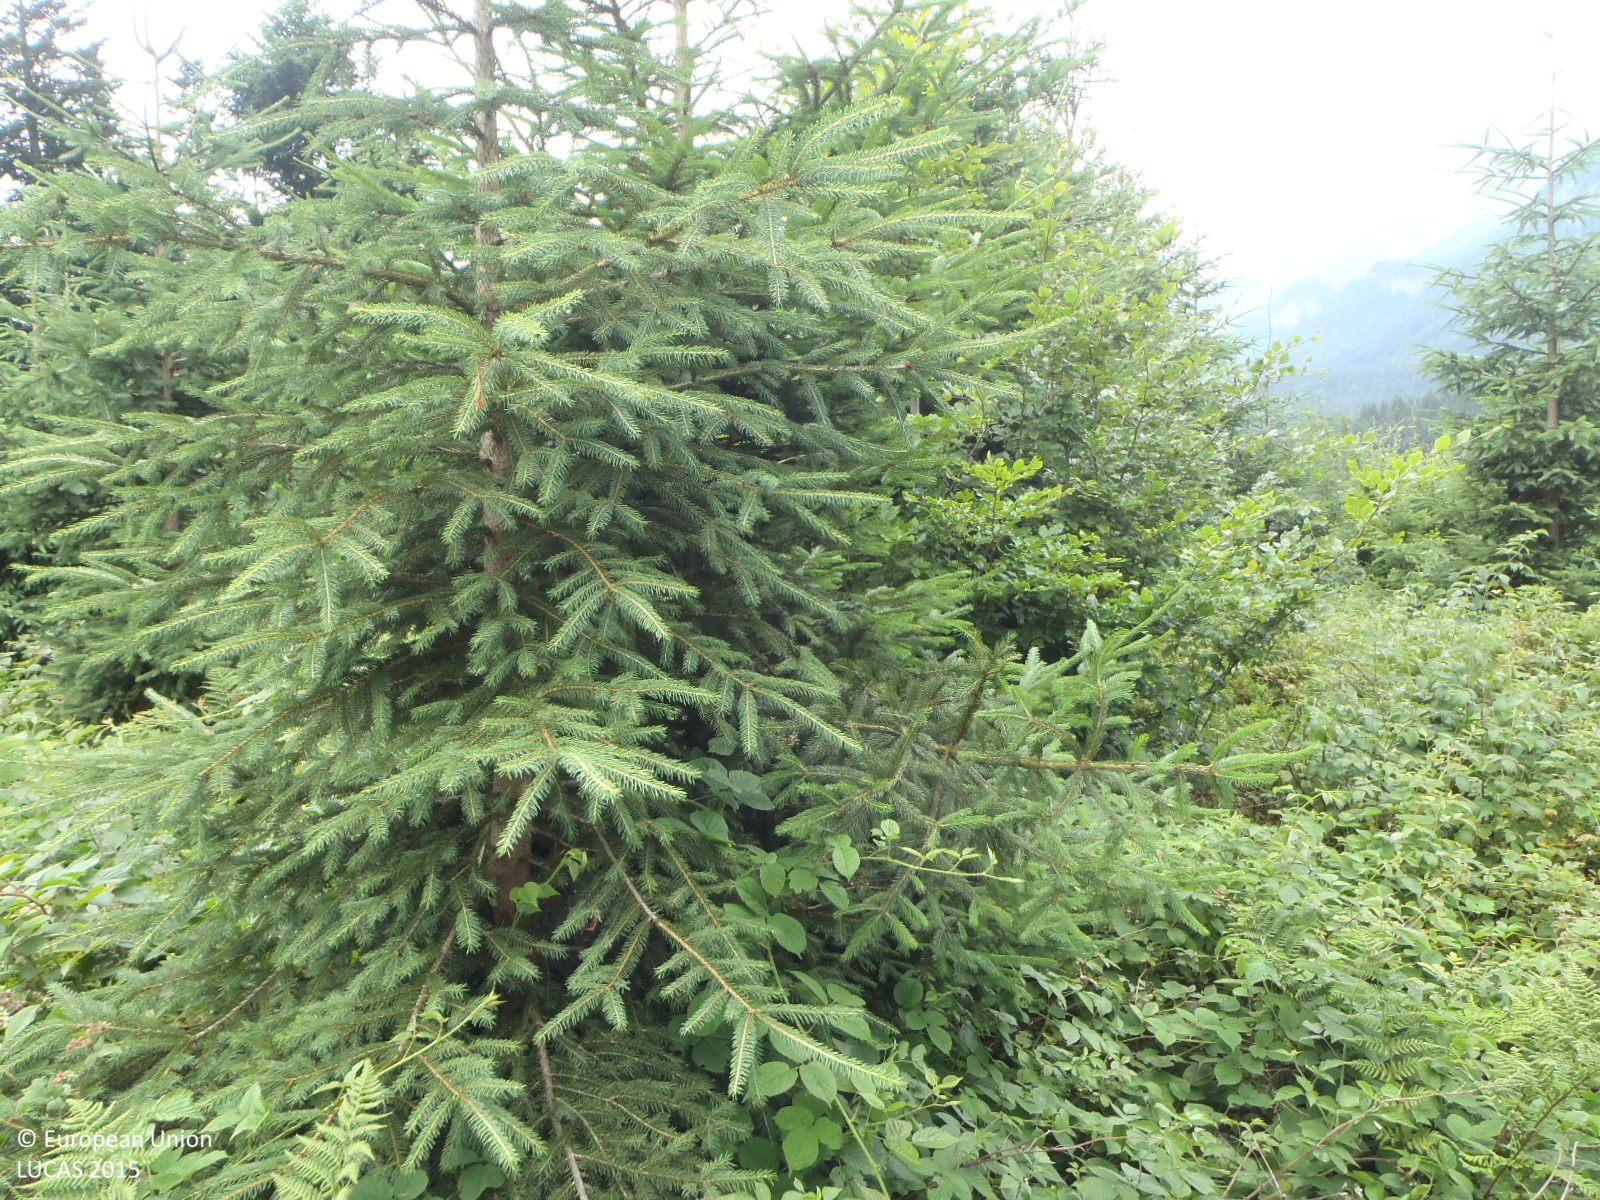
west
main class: Woodland
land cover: Other coniferous woodland
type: alpine coniferous forest
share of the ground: > 75 %
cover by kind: shrubs 55 %, coniferous forest trees 25 %, herbaceous plants 15 %, broadleaved forest trees 5 %
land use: Forestry
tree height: < 5 m
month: July
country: AT
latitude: 47.5312
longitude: 12.4026
